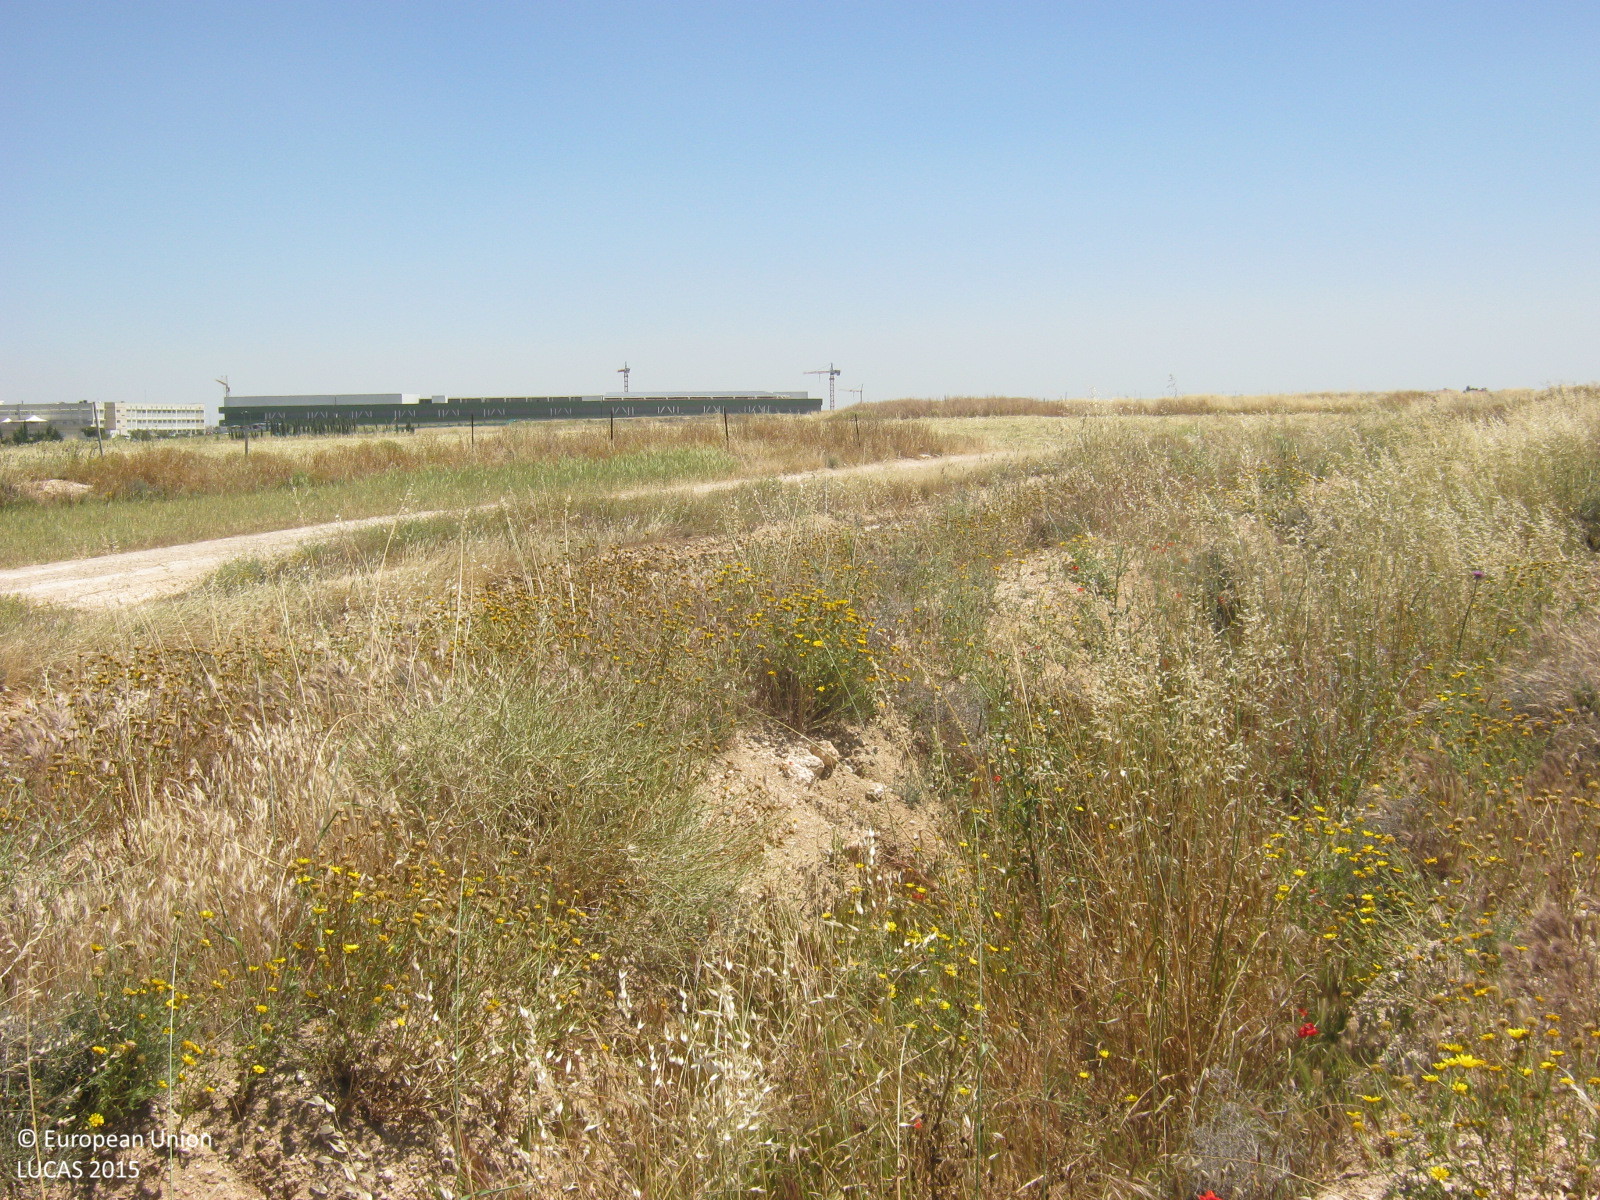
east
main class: Grassland
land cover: Spontaneously vegetated surfaces
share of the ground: > 75 %
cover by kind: herbaceous plants 100 %
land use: Semi-natural and natural areas not in use
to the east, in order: Spontaneously vegetated surfaces; Inland fresh running water; Spontaneously vegetated surfaces; Tracks; Spontaneously vegetated surfaces; Fences; Spontaneously vegetated surfaces; Other bare soil; Spontaneously vegetated surfaces; Other bare soil; Spontaneously vegetated surfaces; Other bare soil; Common wheat
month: April
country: CY
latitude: 35.1373
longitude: 33.2699
